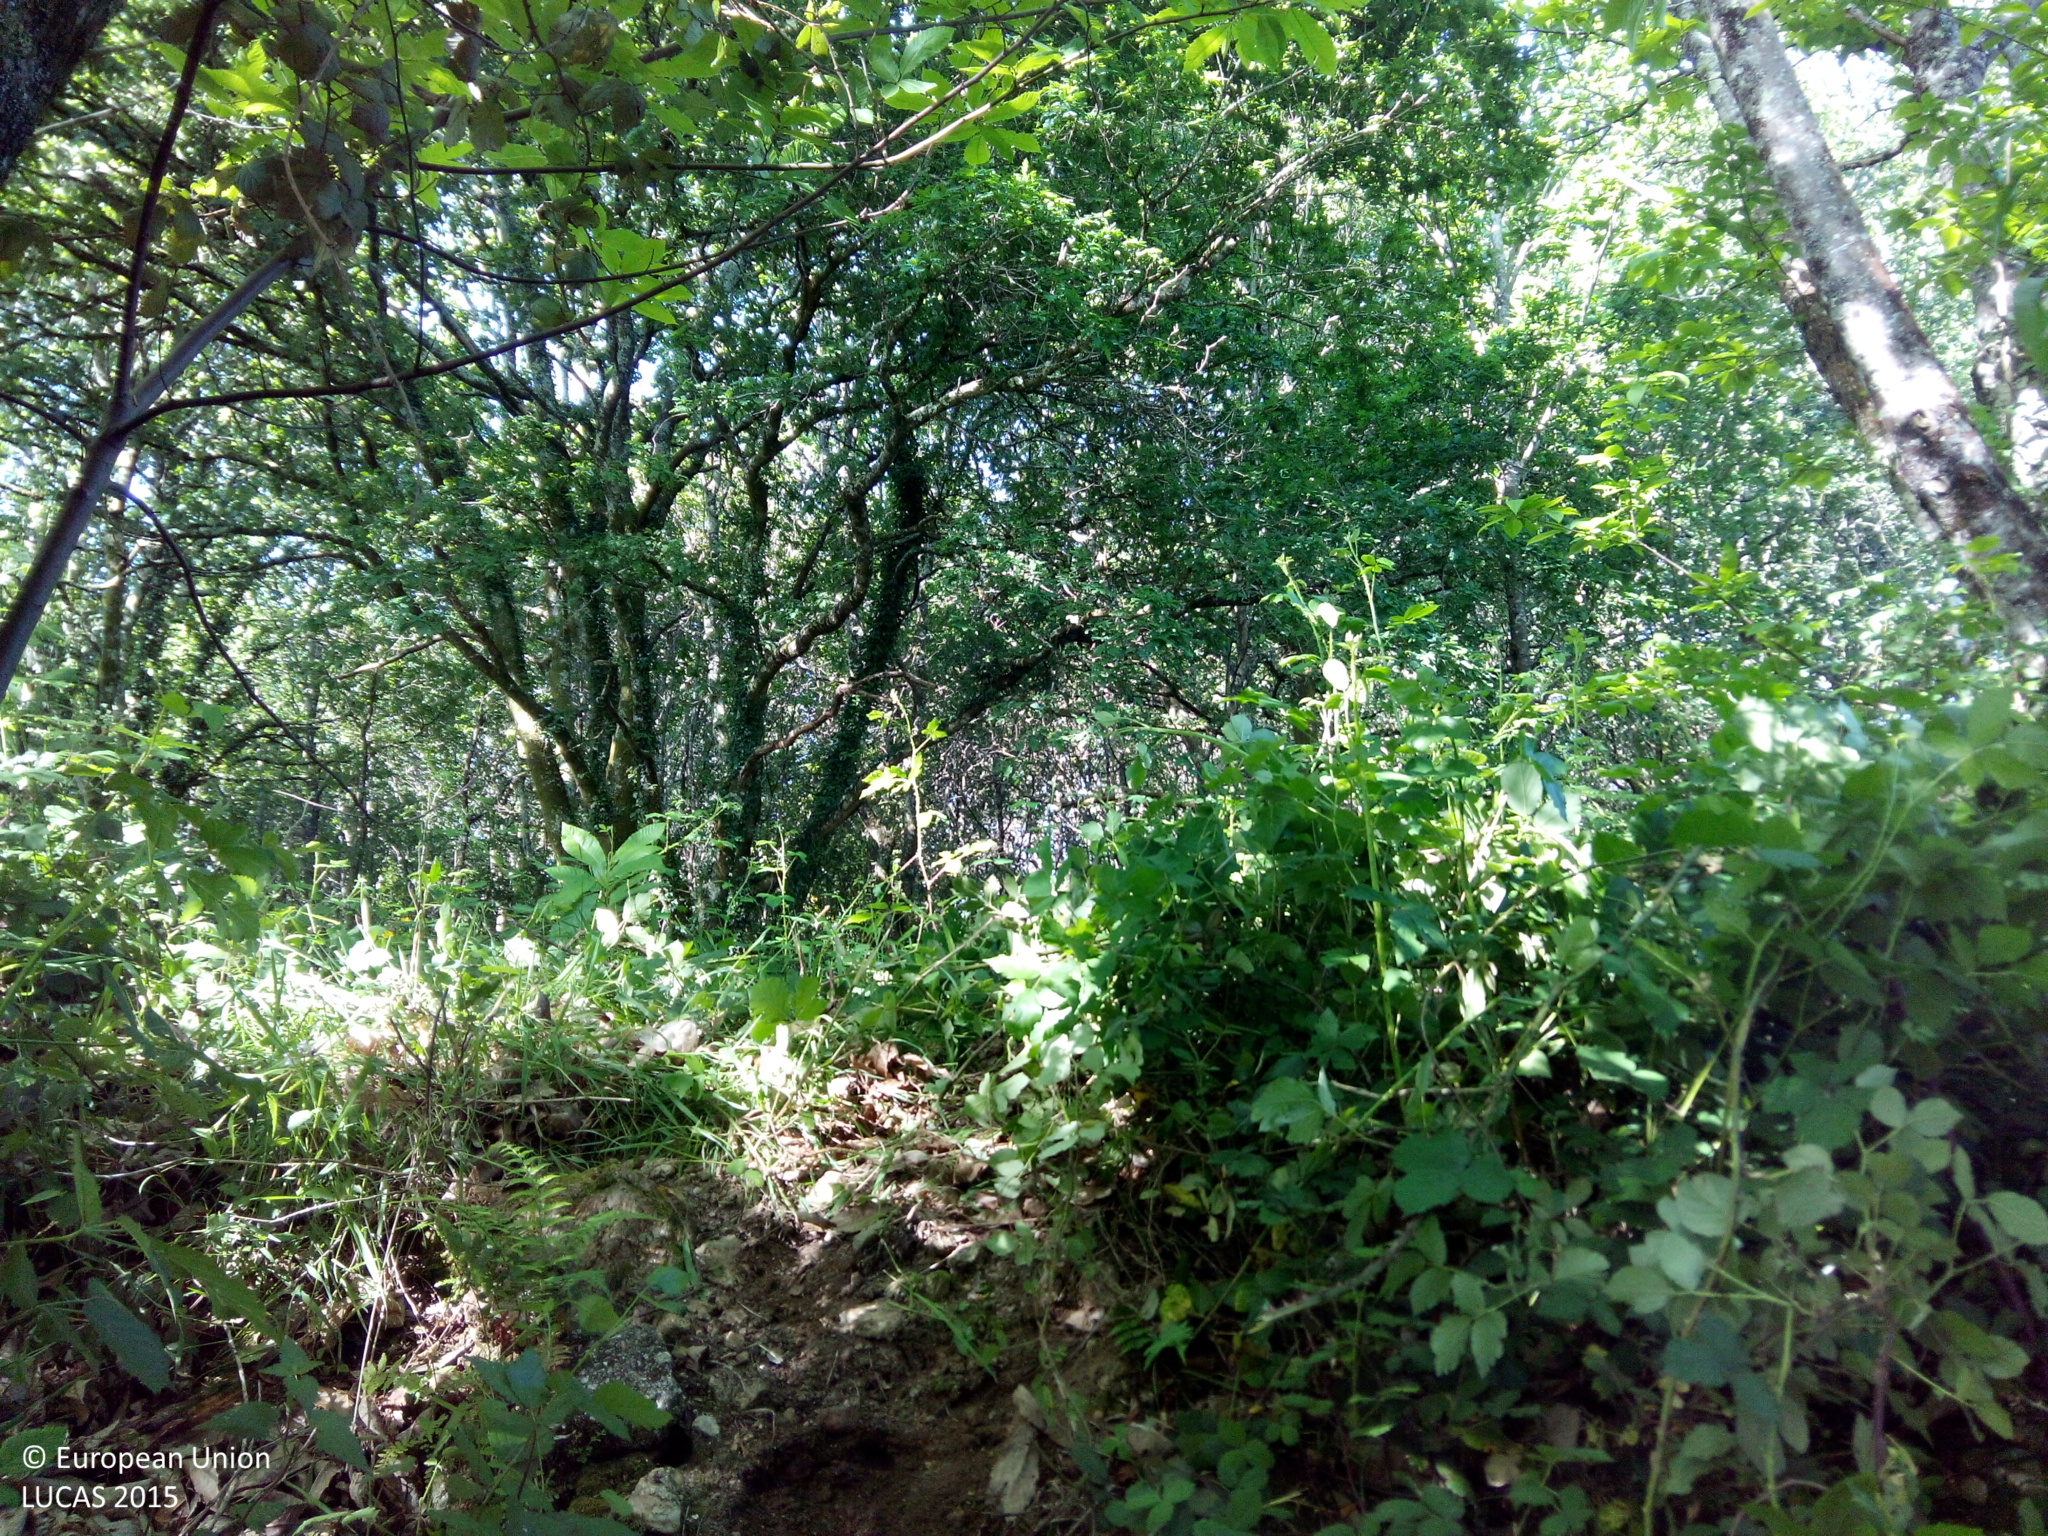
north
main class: Woodland
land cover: Broadleaved woodland
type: acidophilous oak and oak-birch forest
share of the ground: > 75 %
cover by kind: broadleaved forest trees 100 %
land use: Forestry
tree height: > 5 m
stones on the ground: 10 - 25 %
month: May
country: ES
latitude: 42.6800
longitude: -8.4408
